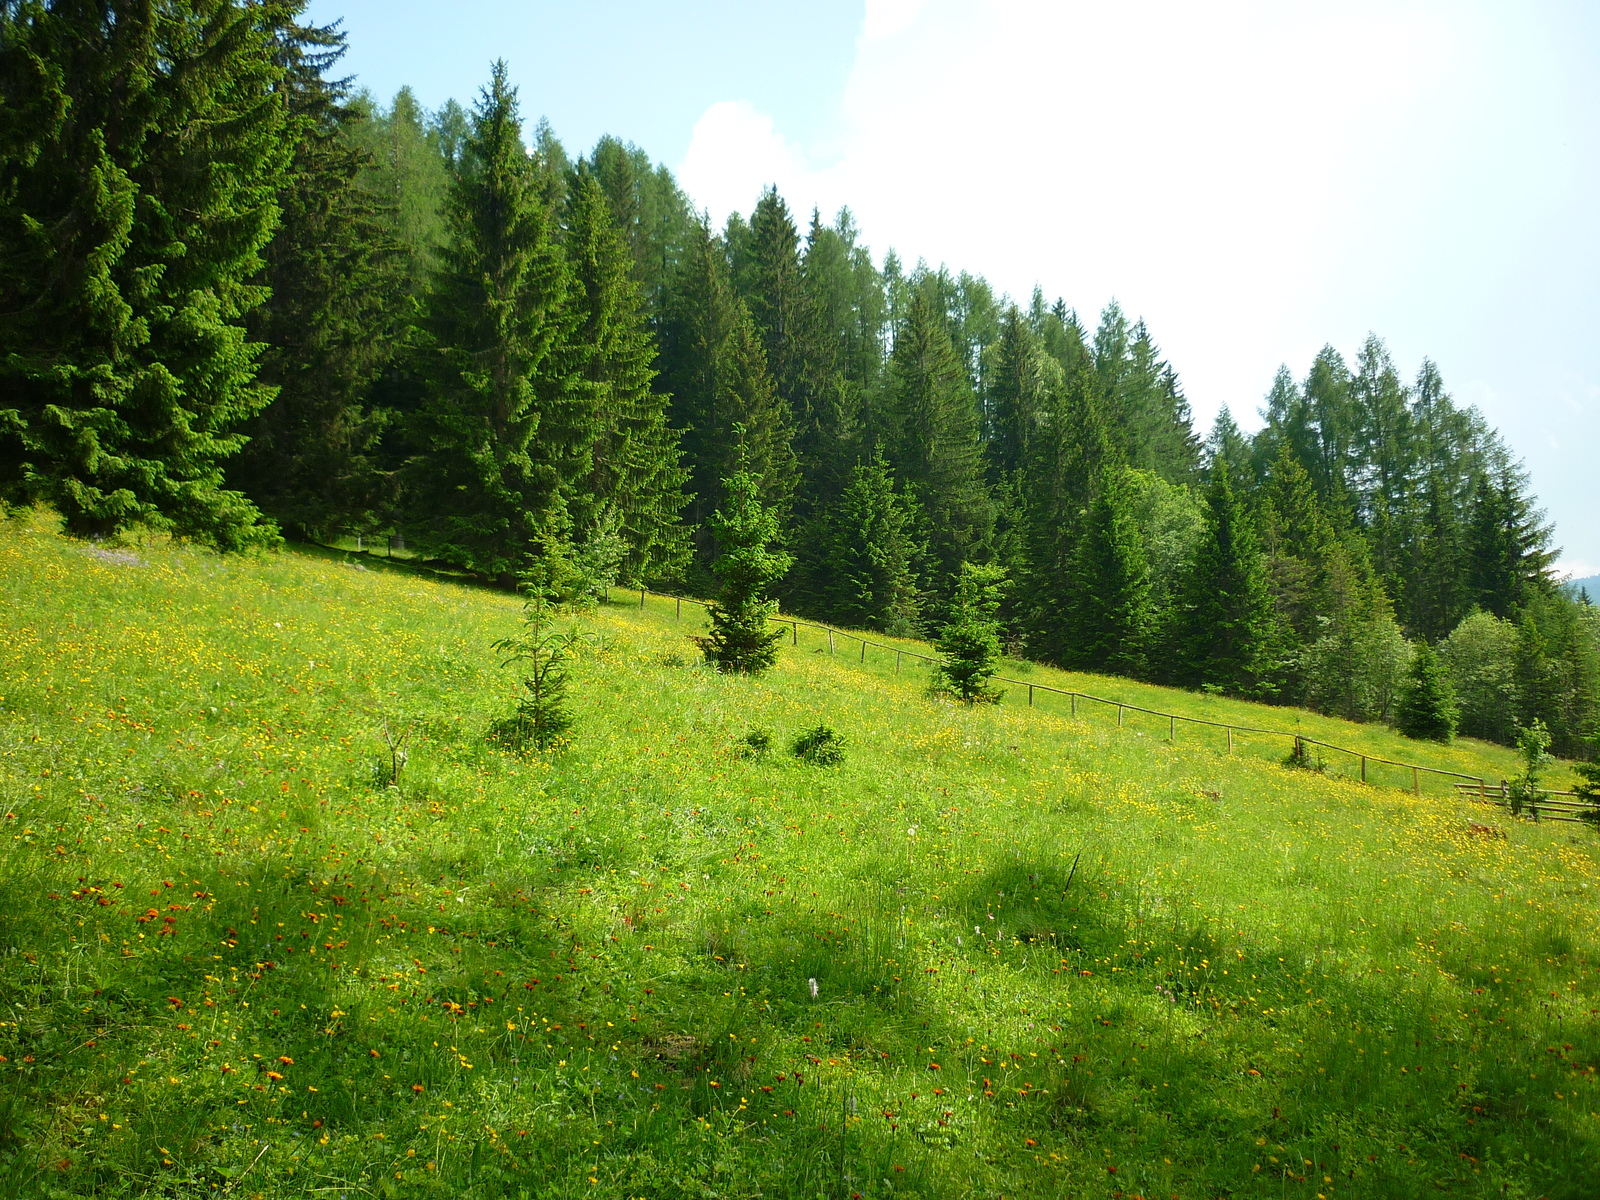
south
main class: Grassland
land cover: Grassland with sparse tree/shrub cover
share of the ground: > 75 %
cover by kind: herbaceous plants 95 %, coniferous forest trees 5 %
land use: Agriculture (excluding fallow land and kitchen gardens)
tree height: < 5 m
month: June
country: AT
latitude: 47.1761
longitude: 14.0489
